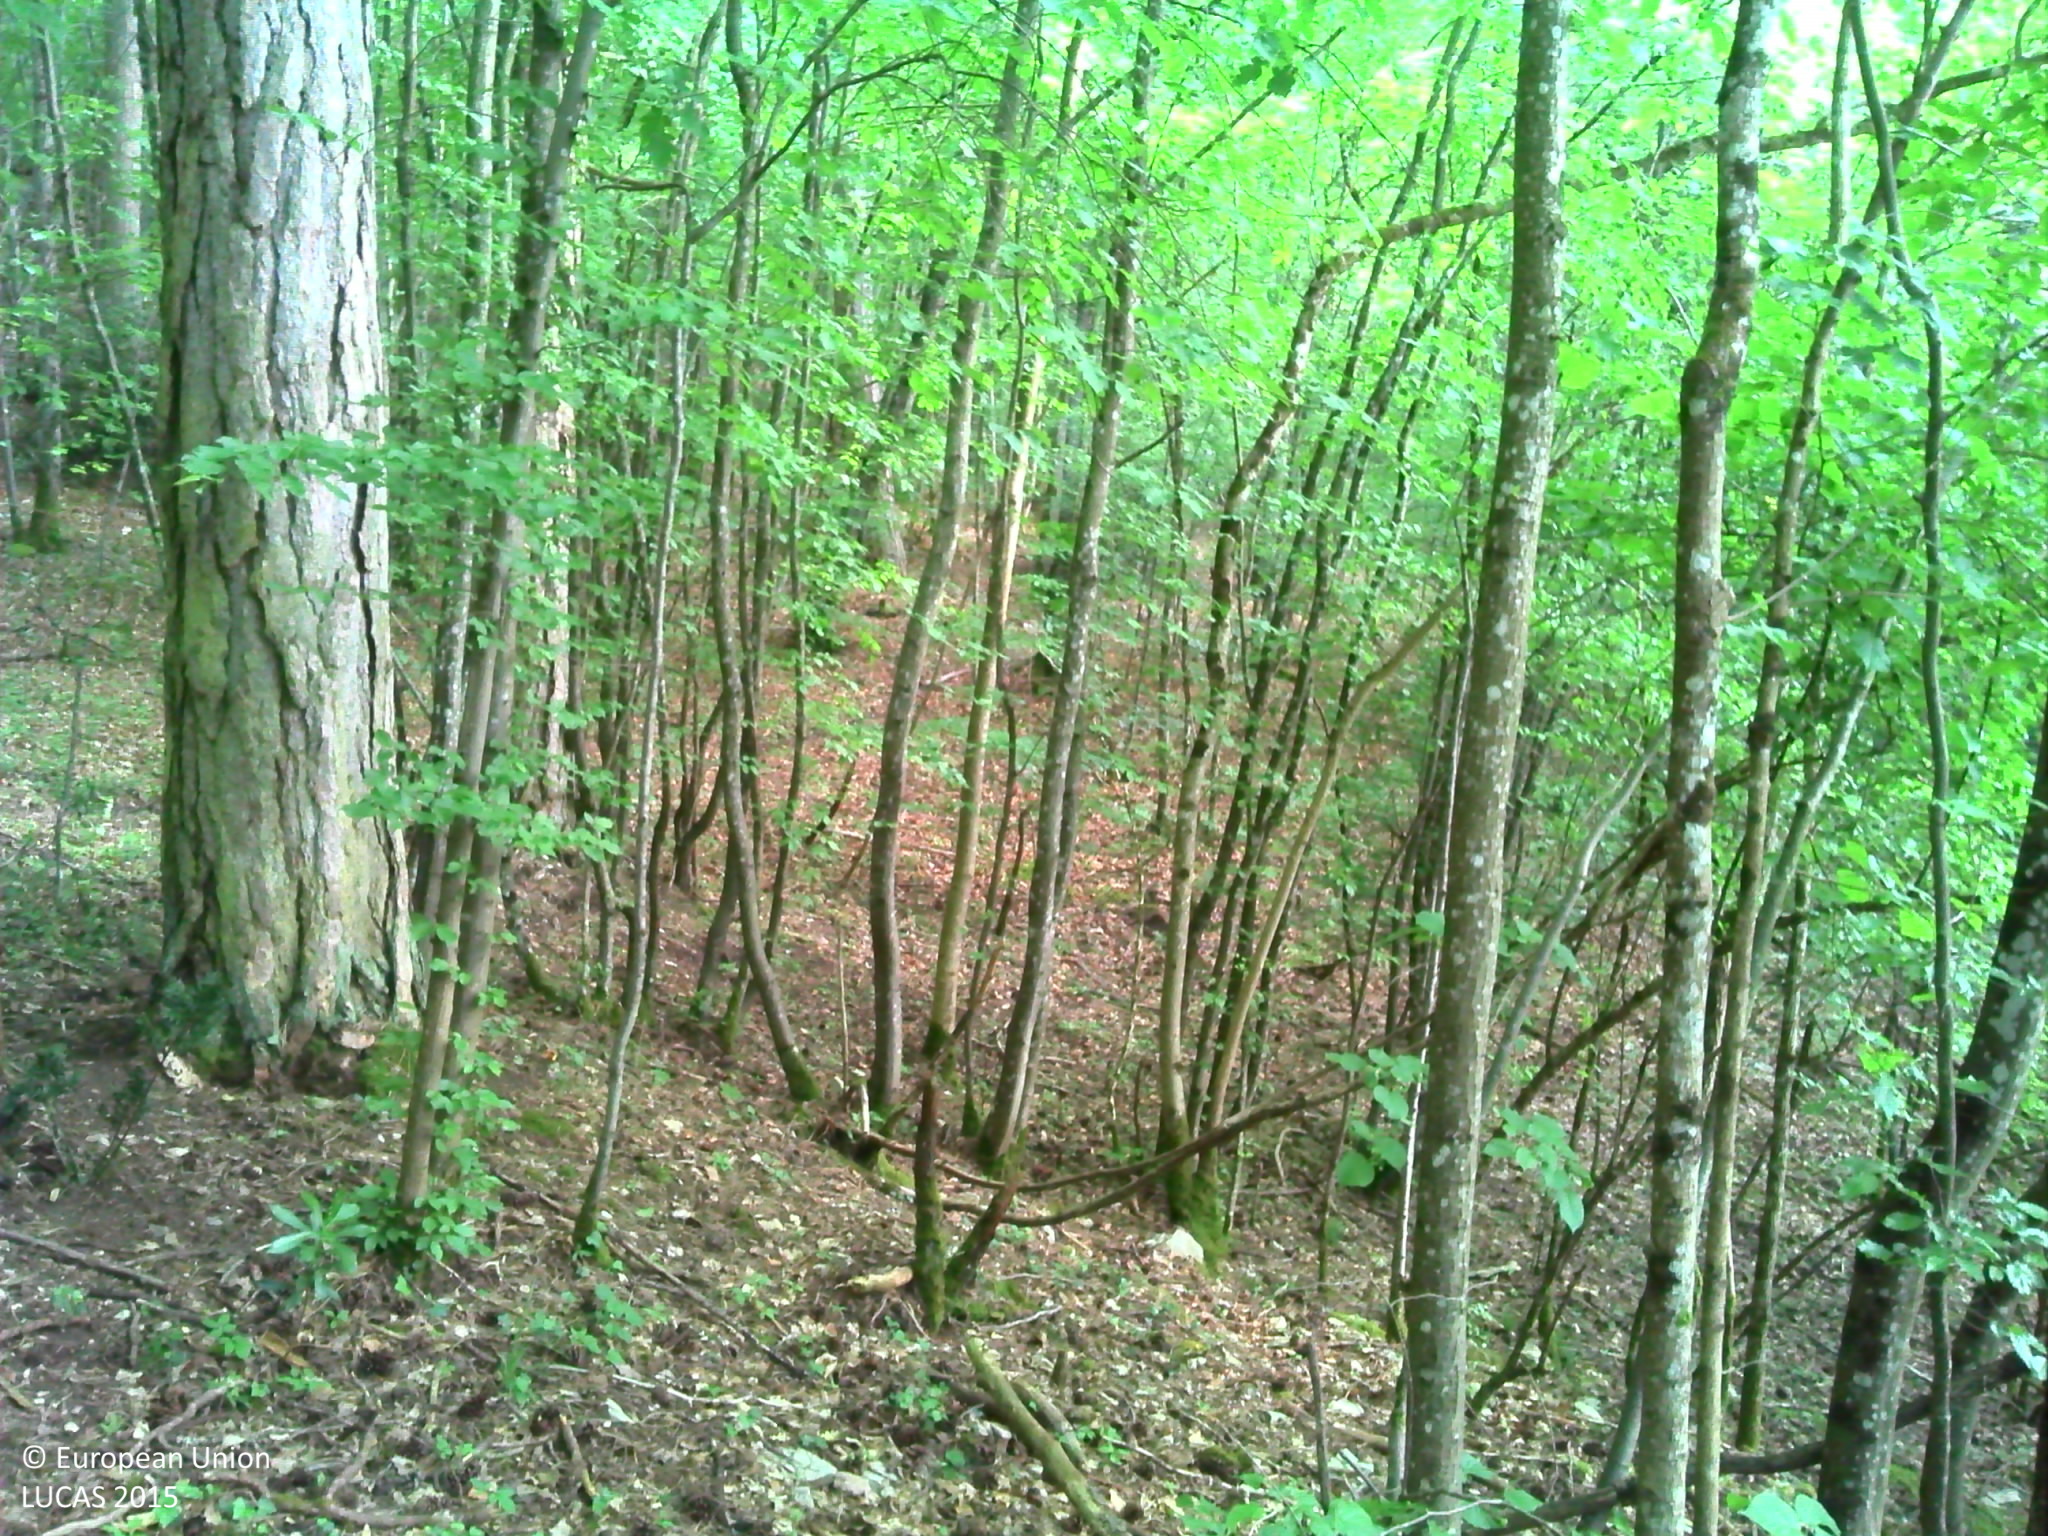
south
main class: Woodland
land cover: Pine dominated mixed woodland
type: mesophytic deciduous forest
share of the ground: > 75 %
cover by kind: broadleaved forest trees 55 %, coniferous forest trees 25 %, herbaceous plants 15 %, lichens and mosses 5 %
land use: Forestry
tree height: > 5 m
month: May
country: FR
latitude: 47.3137
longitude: 4.9338
